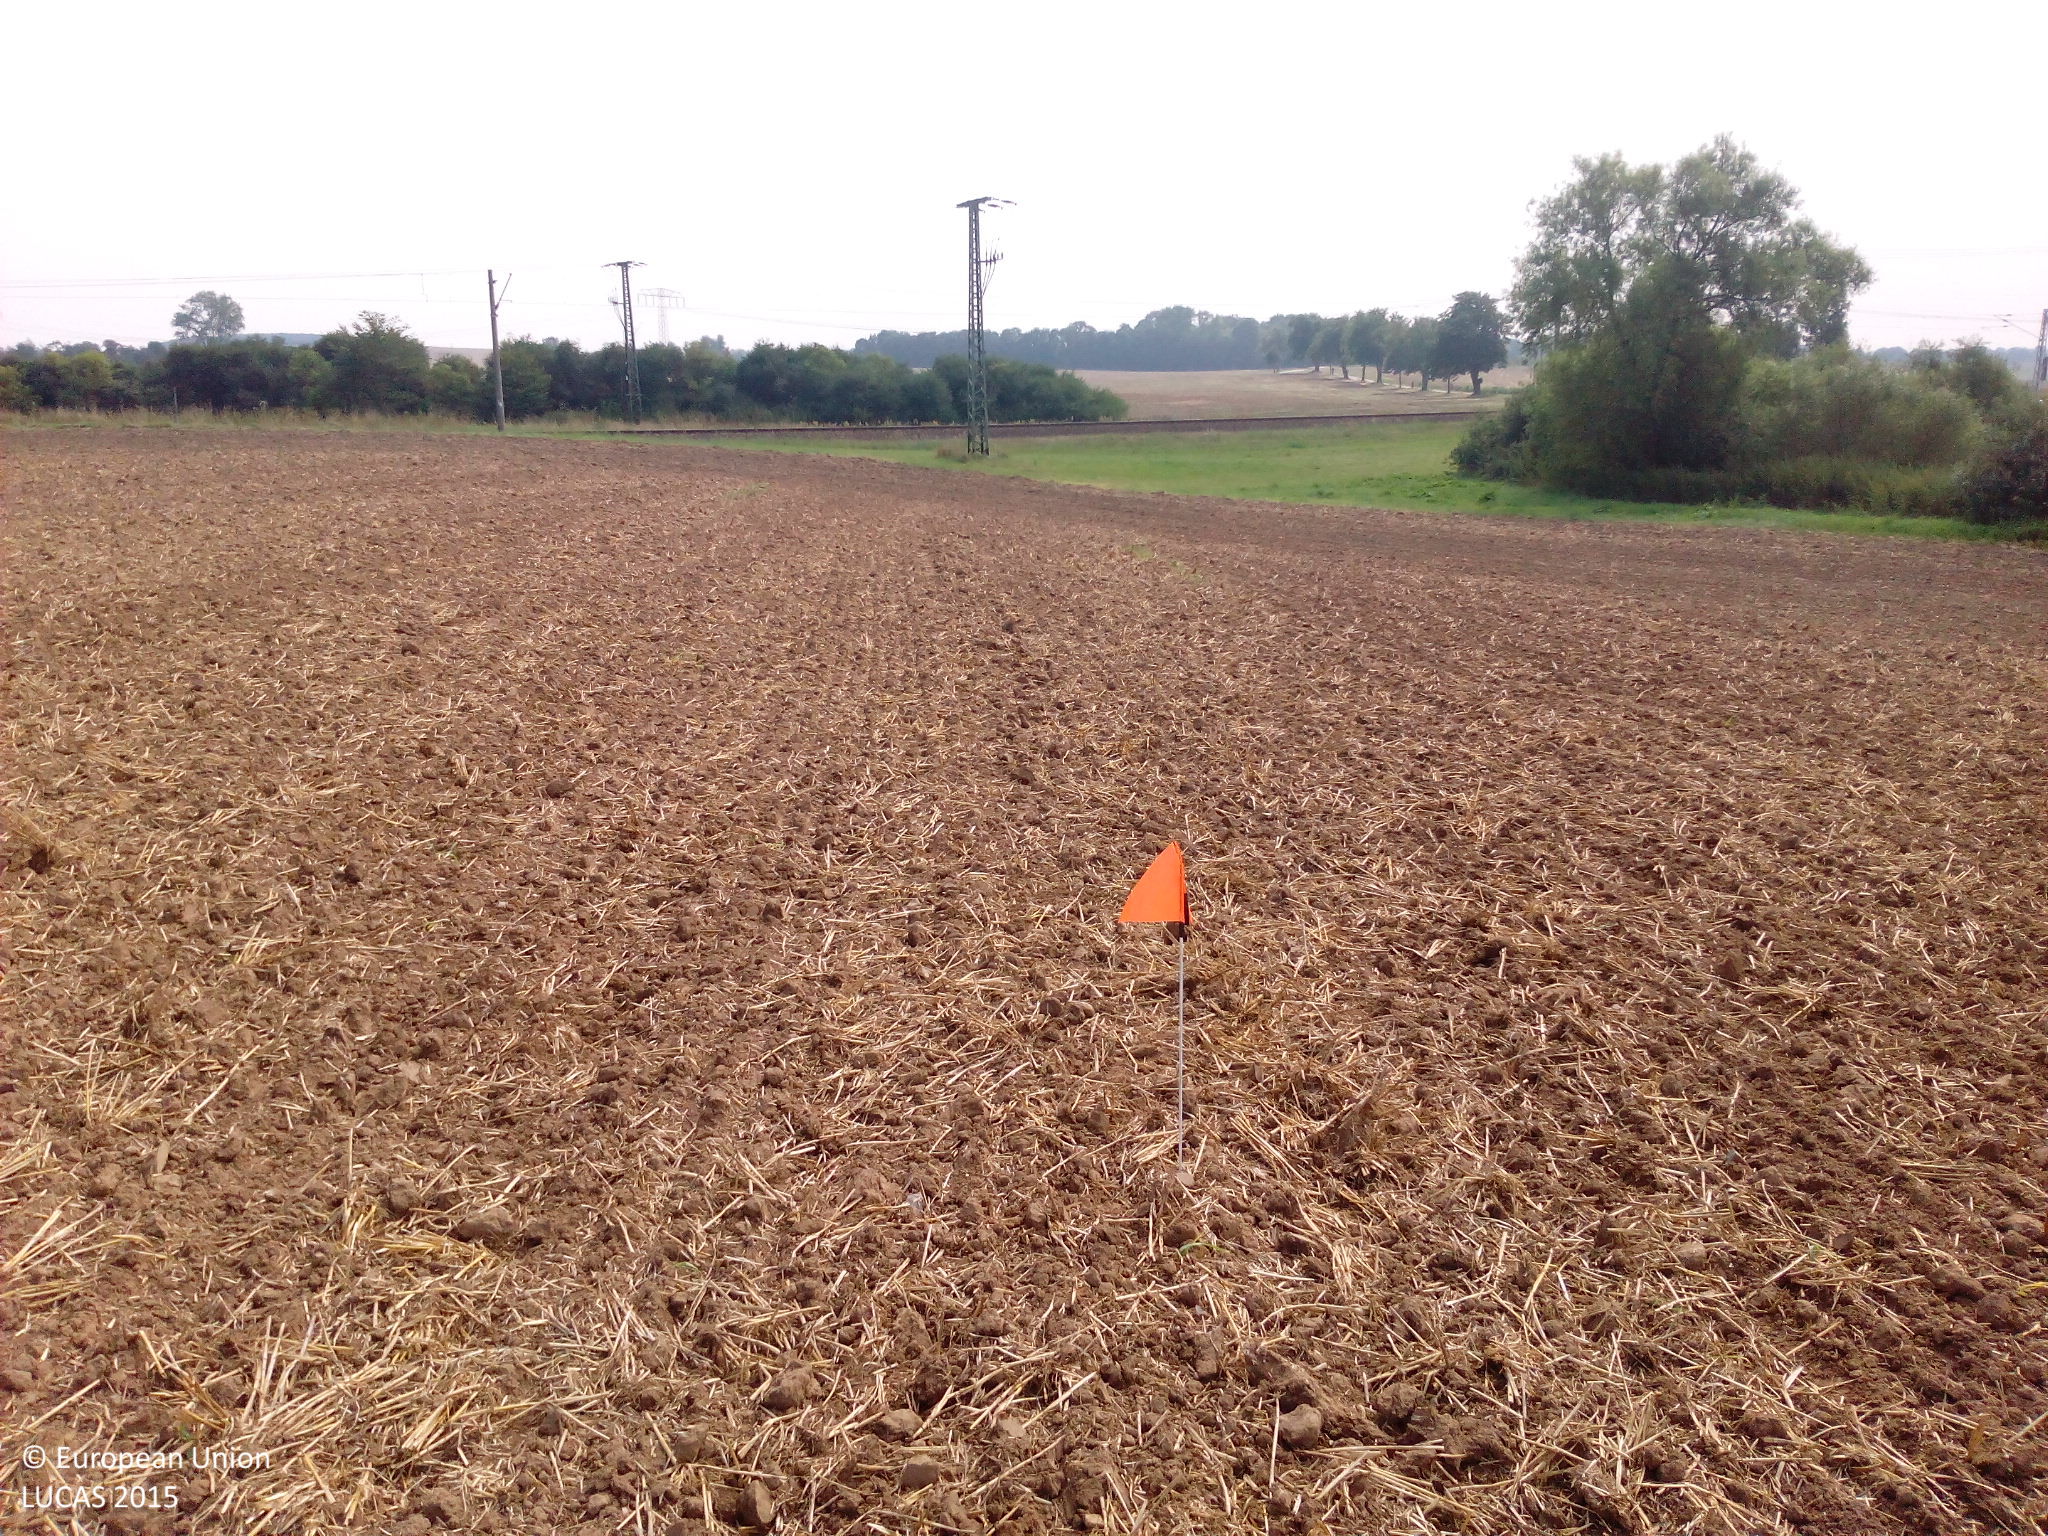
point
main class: Cropland
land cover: Rye
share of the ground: < 10 %
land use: Agriculture (excluding fallow land and kitchen gardens)
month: August
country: DE
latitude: 53.8292
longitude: 12.3238
